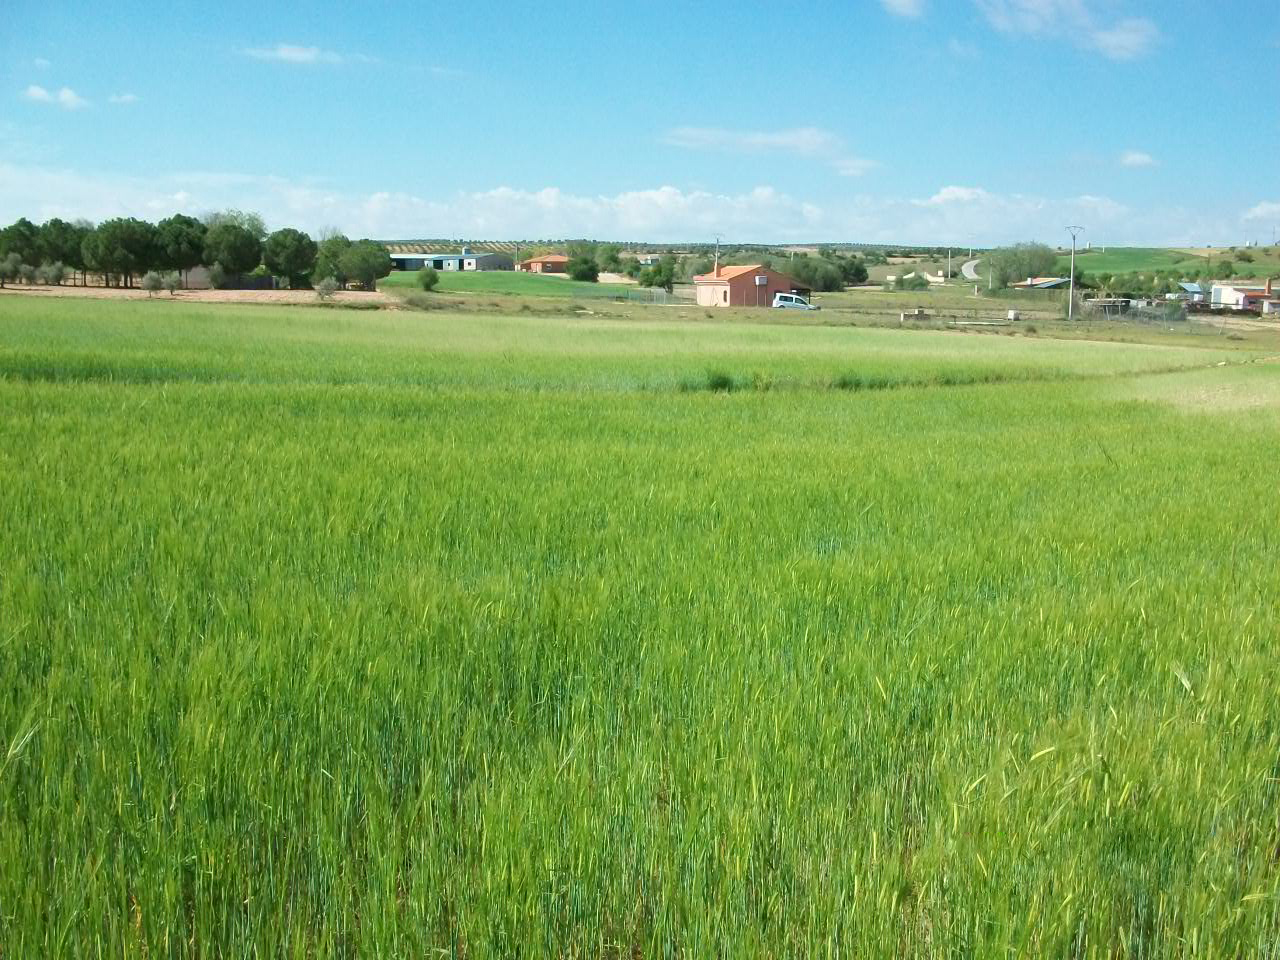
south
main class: Cropland
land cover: Barley
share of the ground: > 75 %
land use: Agriculture (excluding fallow land and kitchen gardens)
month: April
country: ES
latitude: 39.8664
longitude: -3.7200
